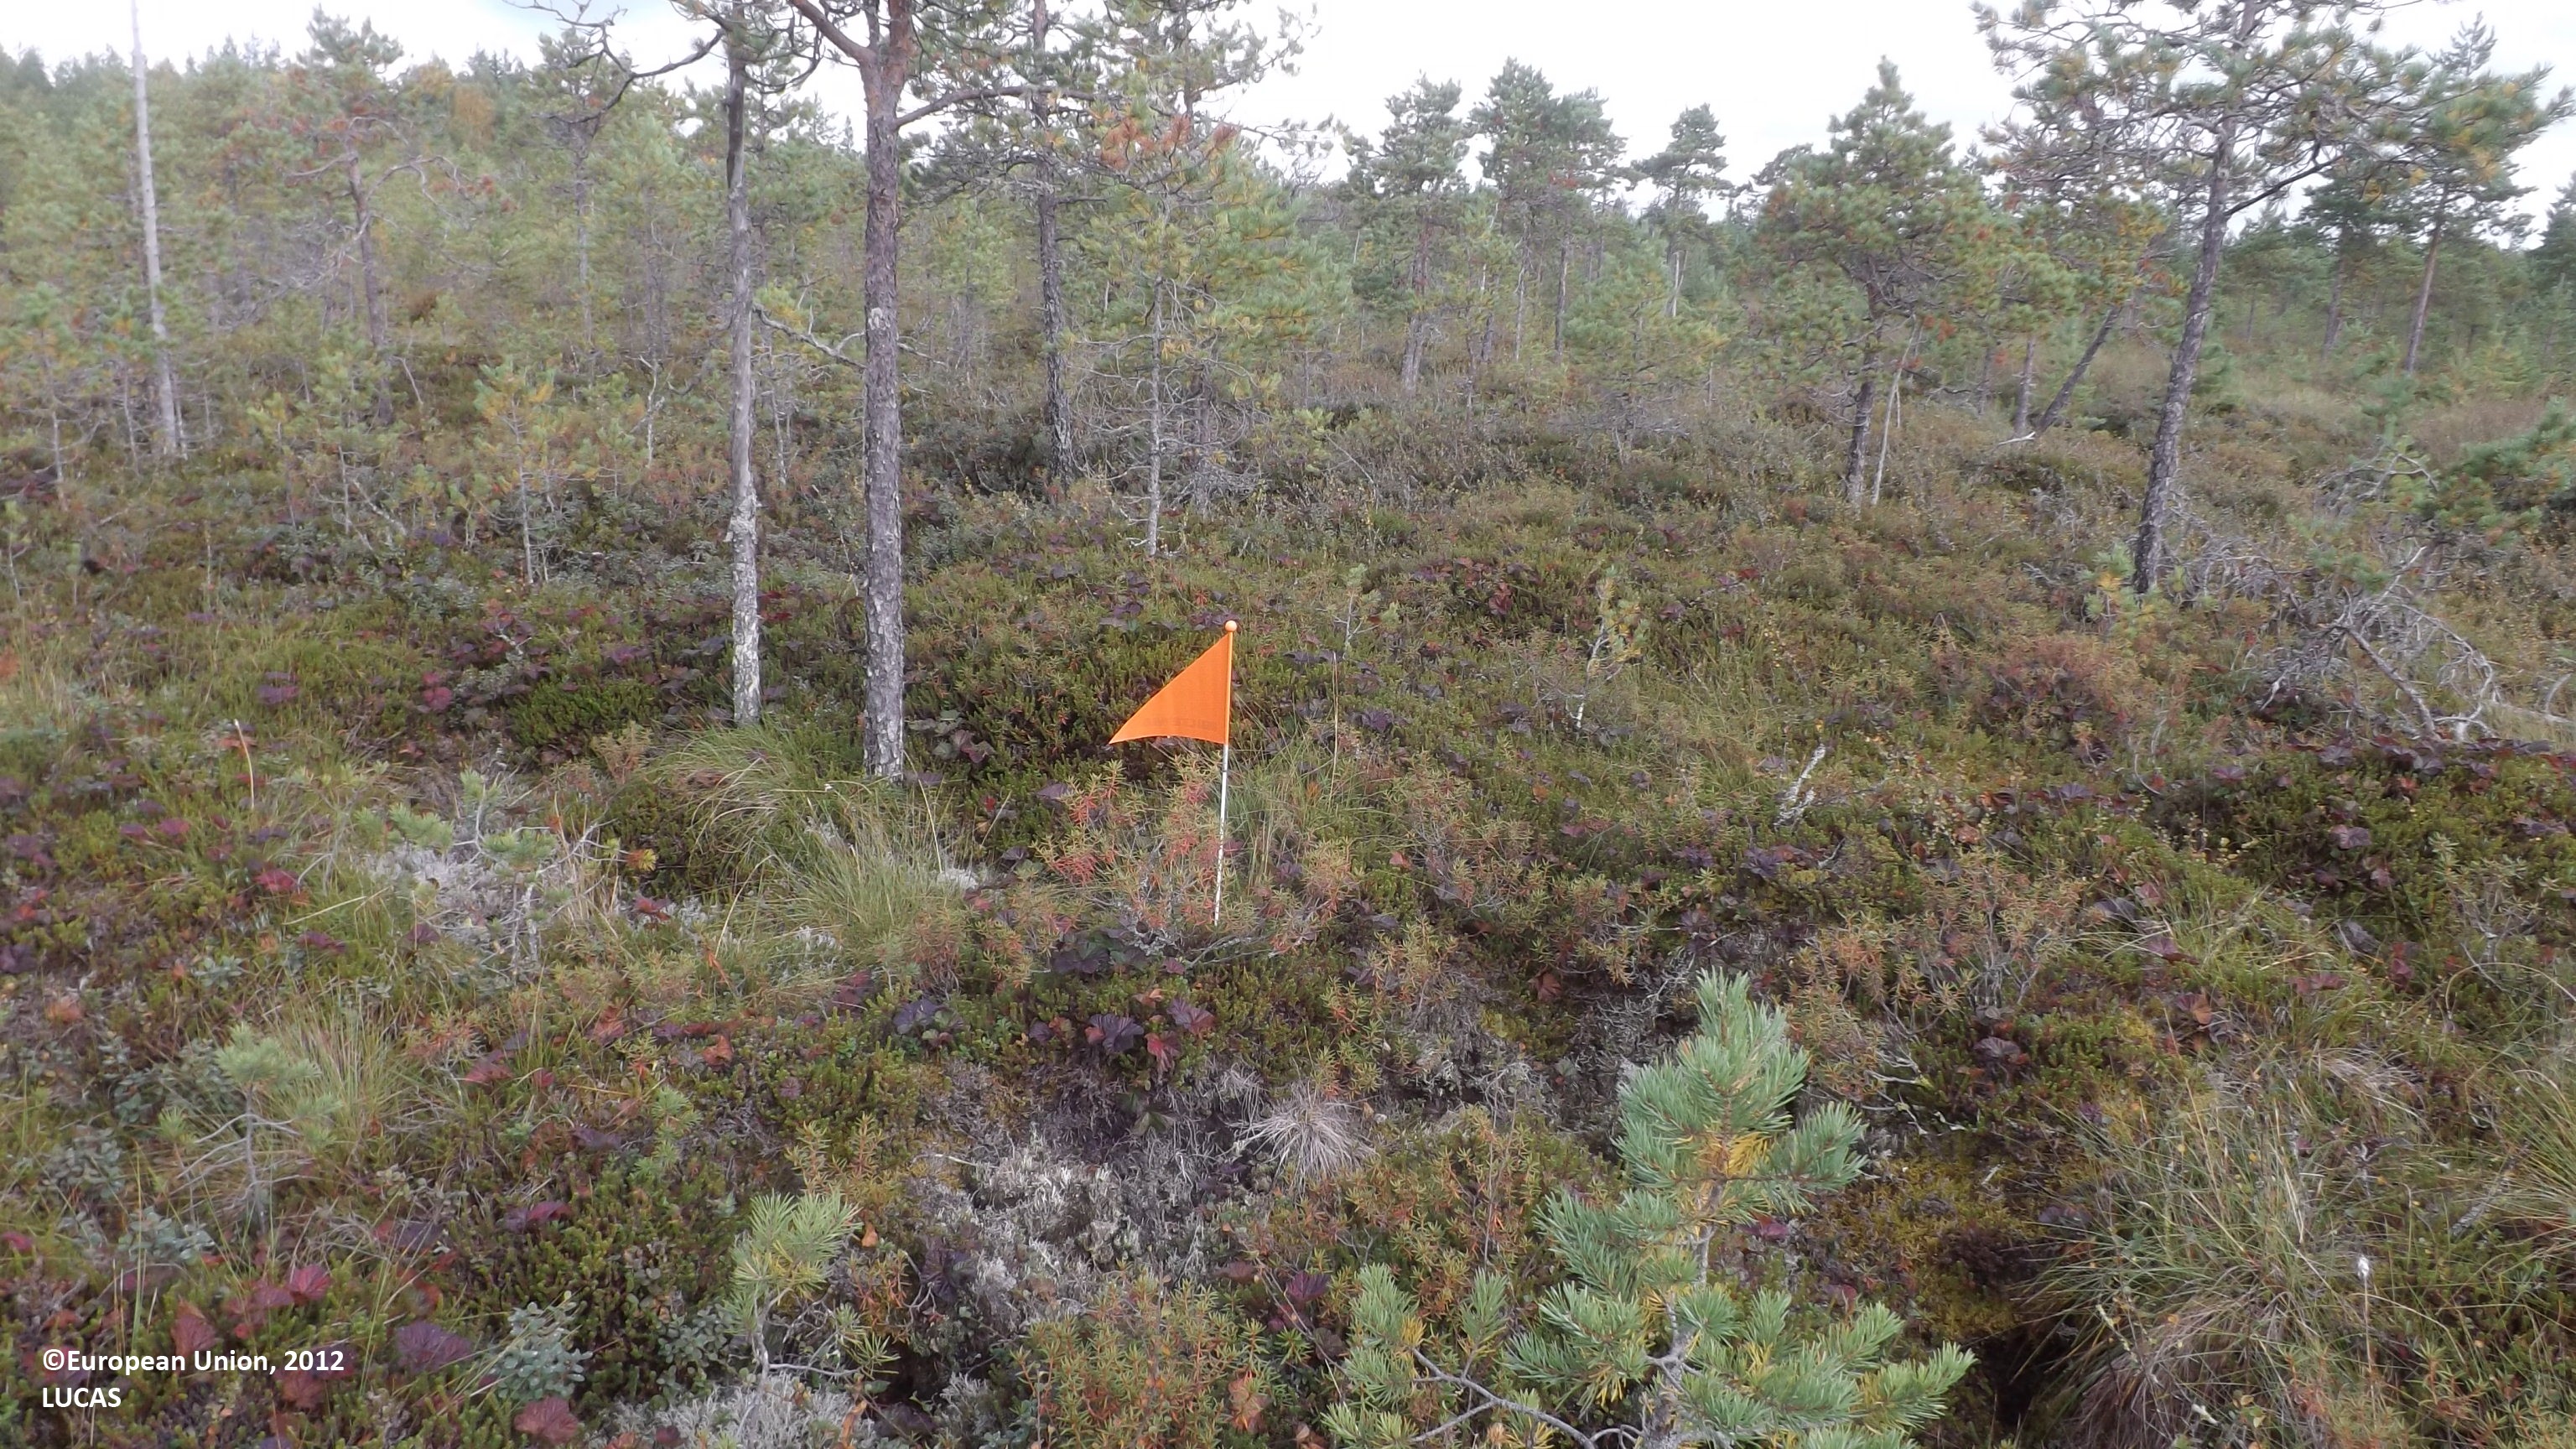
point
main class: Woodland
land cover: Pine dominated coniferous woodland
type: mire and swamp forests
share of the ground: 10 - 25 %
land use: Forestry
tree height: < 5 m
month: August
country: FI
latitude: 63.8617
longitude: 23.6309
